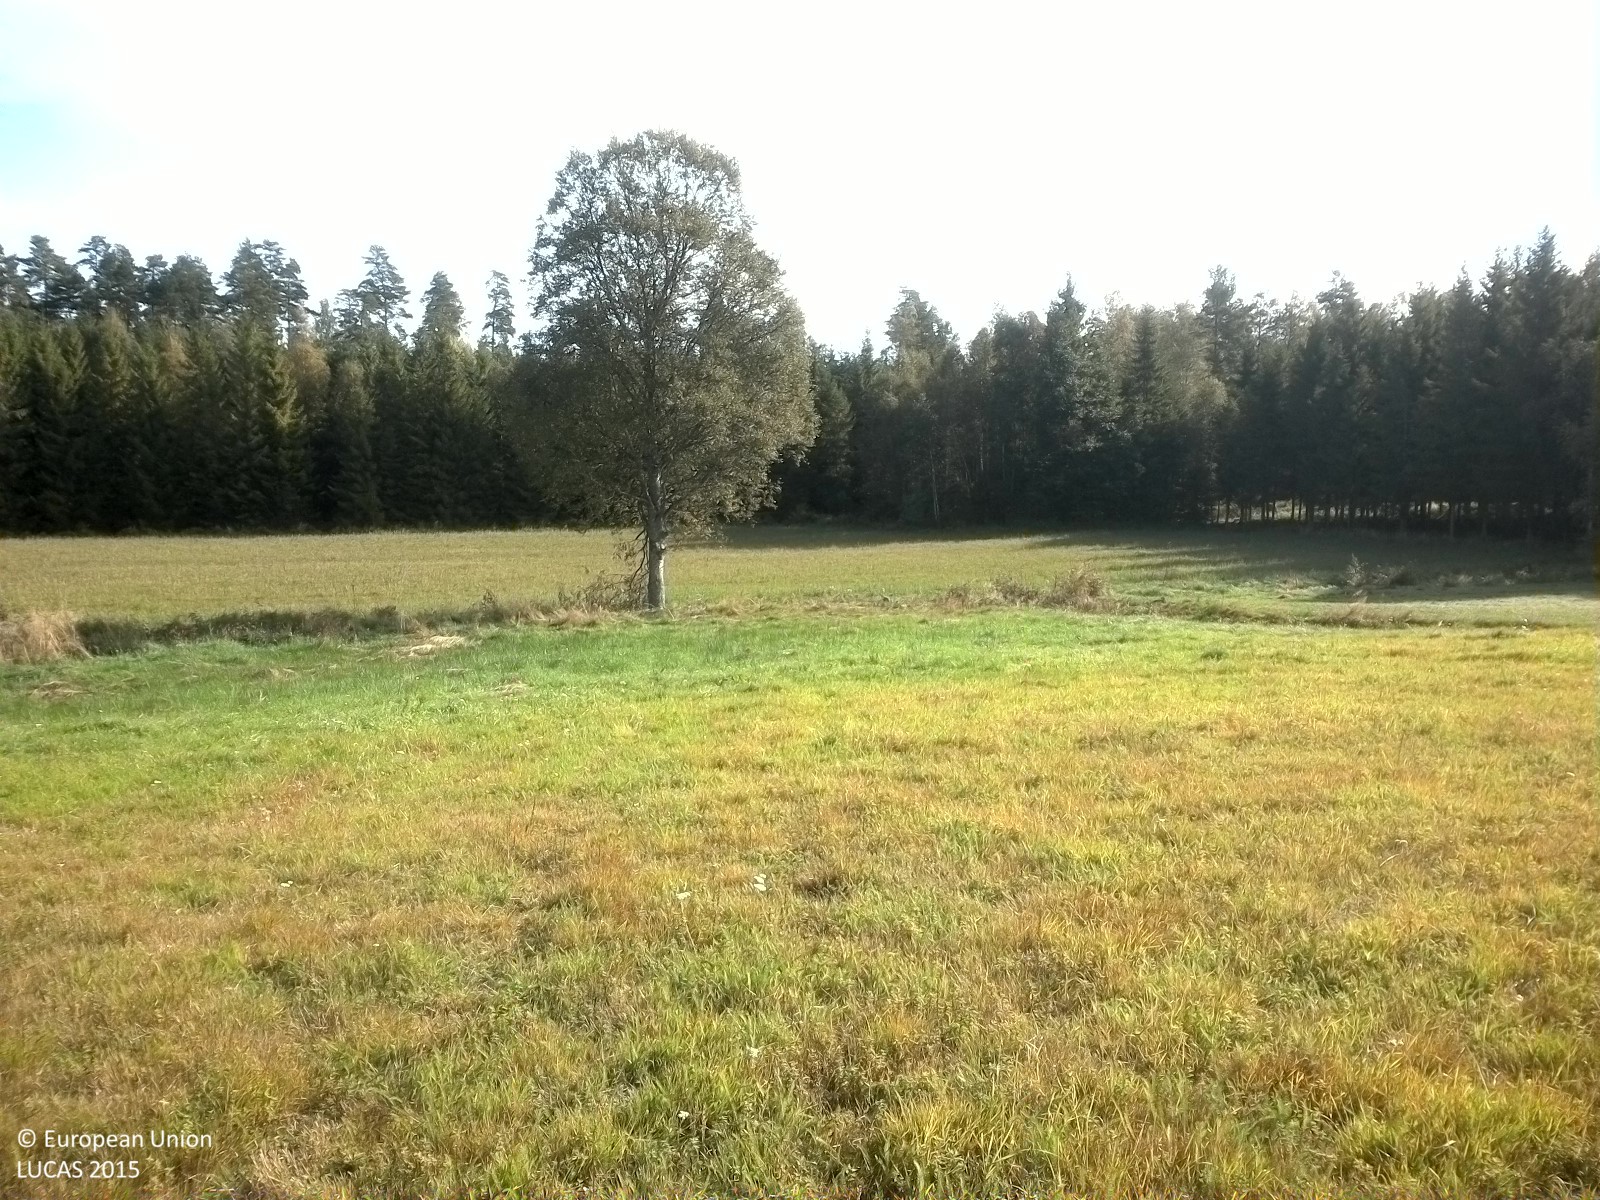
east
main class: Grassland
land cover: Grassland without tree/shrub cover
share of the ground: > 75 %
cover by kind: herbaceous plants 100 %
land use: Agriculture (excluding fallow land and kitchen gardens)
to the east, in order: Grassland without tree/shrub cover; Ditches and canals; Oats; Spruce dominated mixed woodland; Tracks; Spruce dominated coniferous woodland; Grassland without tree/shrub cover; Other mixed woodland; Spontaneously vegetated surfaces; Other mixed woodland
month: September
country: SE
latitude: 58.9834
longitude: 15.6824
